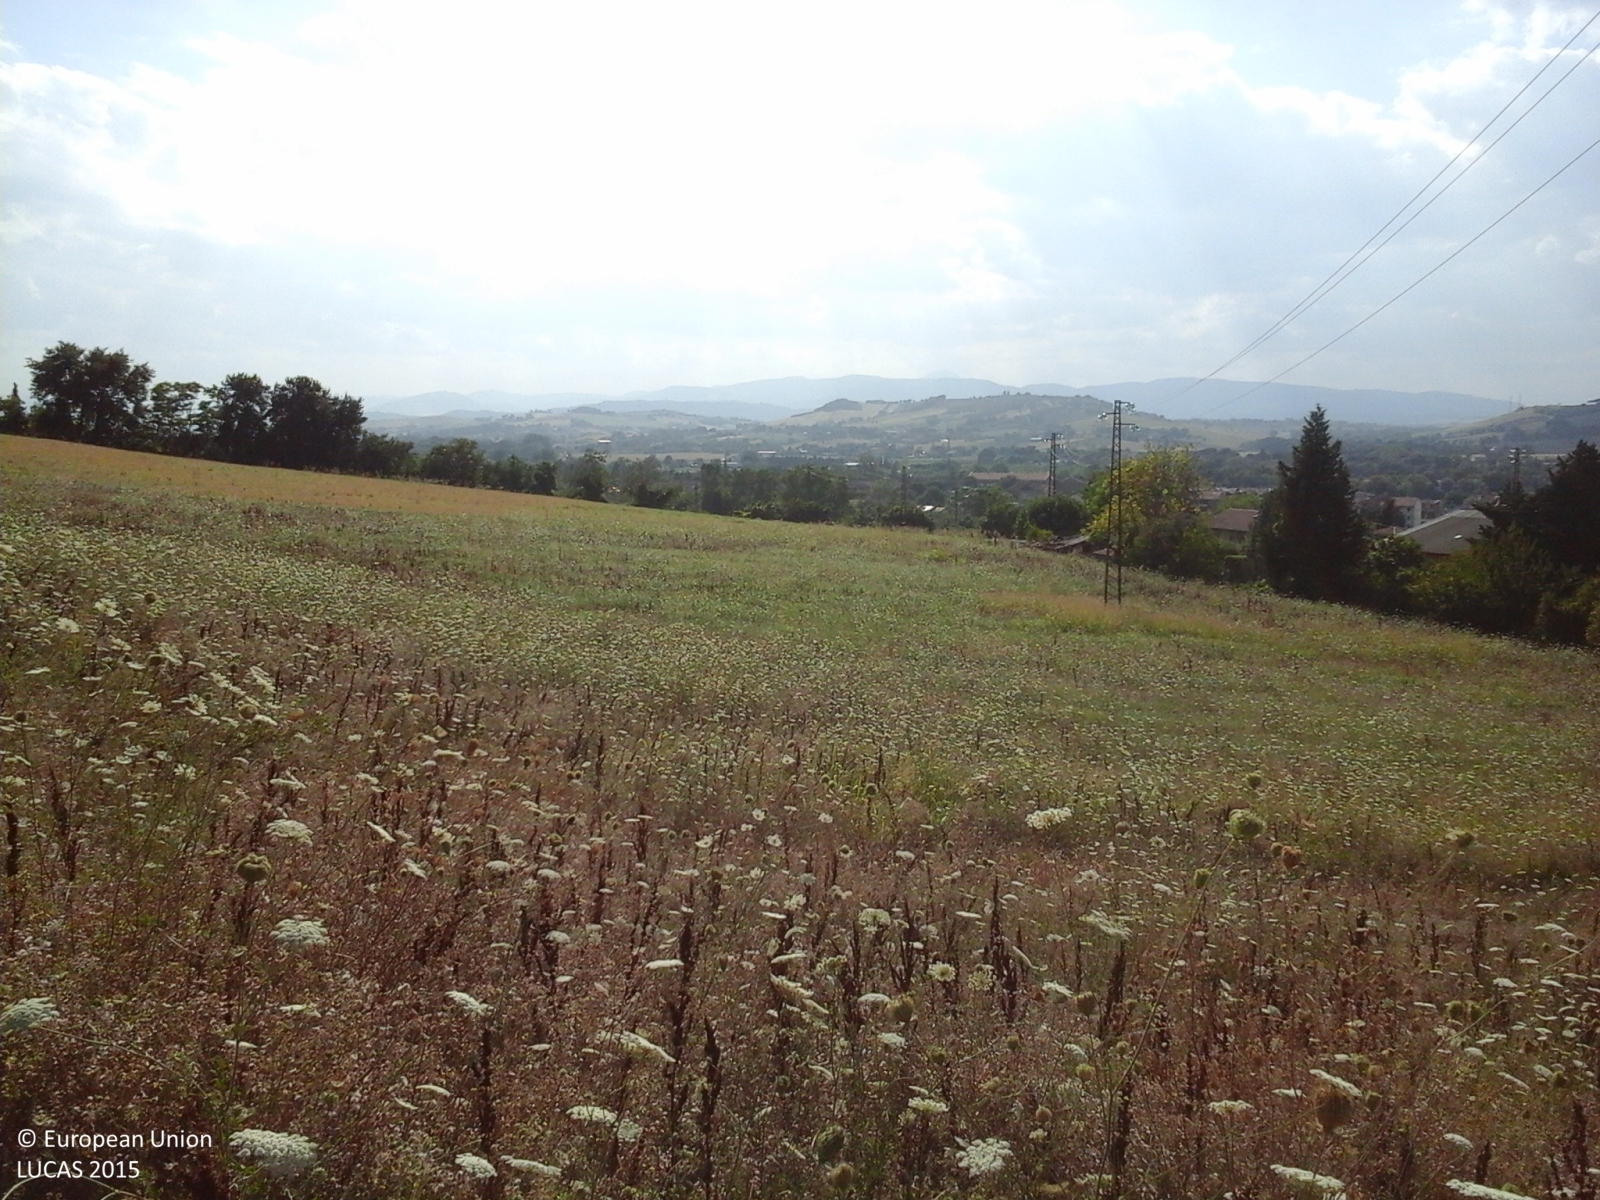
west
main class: Grassland
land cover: Spontaneously vegetated surfaces
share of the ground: > 75 %
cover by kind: herbaceous plants 95 %, shrubs 5 %
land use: Agriculture (excluding fallow land and kitchen gardens)
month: July
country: IT
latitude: 43.3187
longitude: 13.4315
